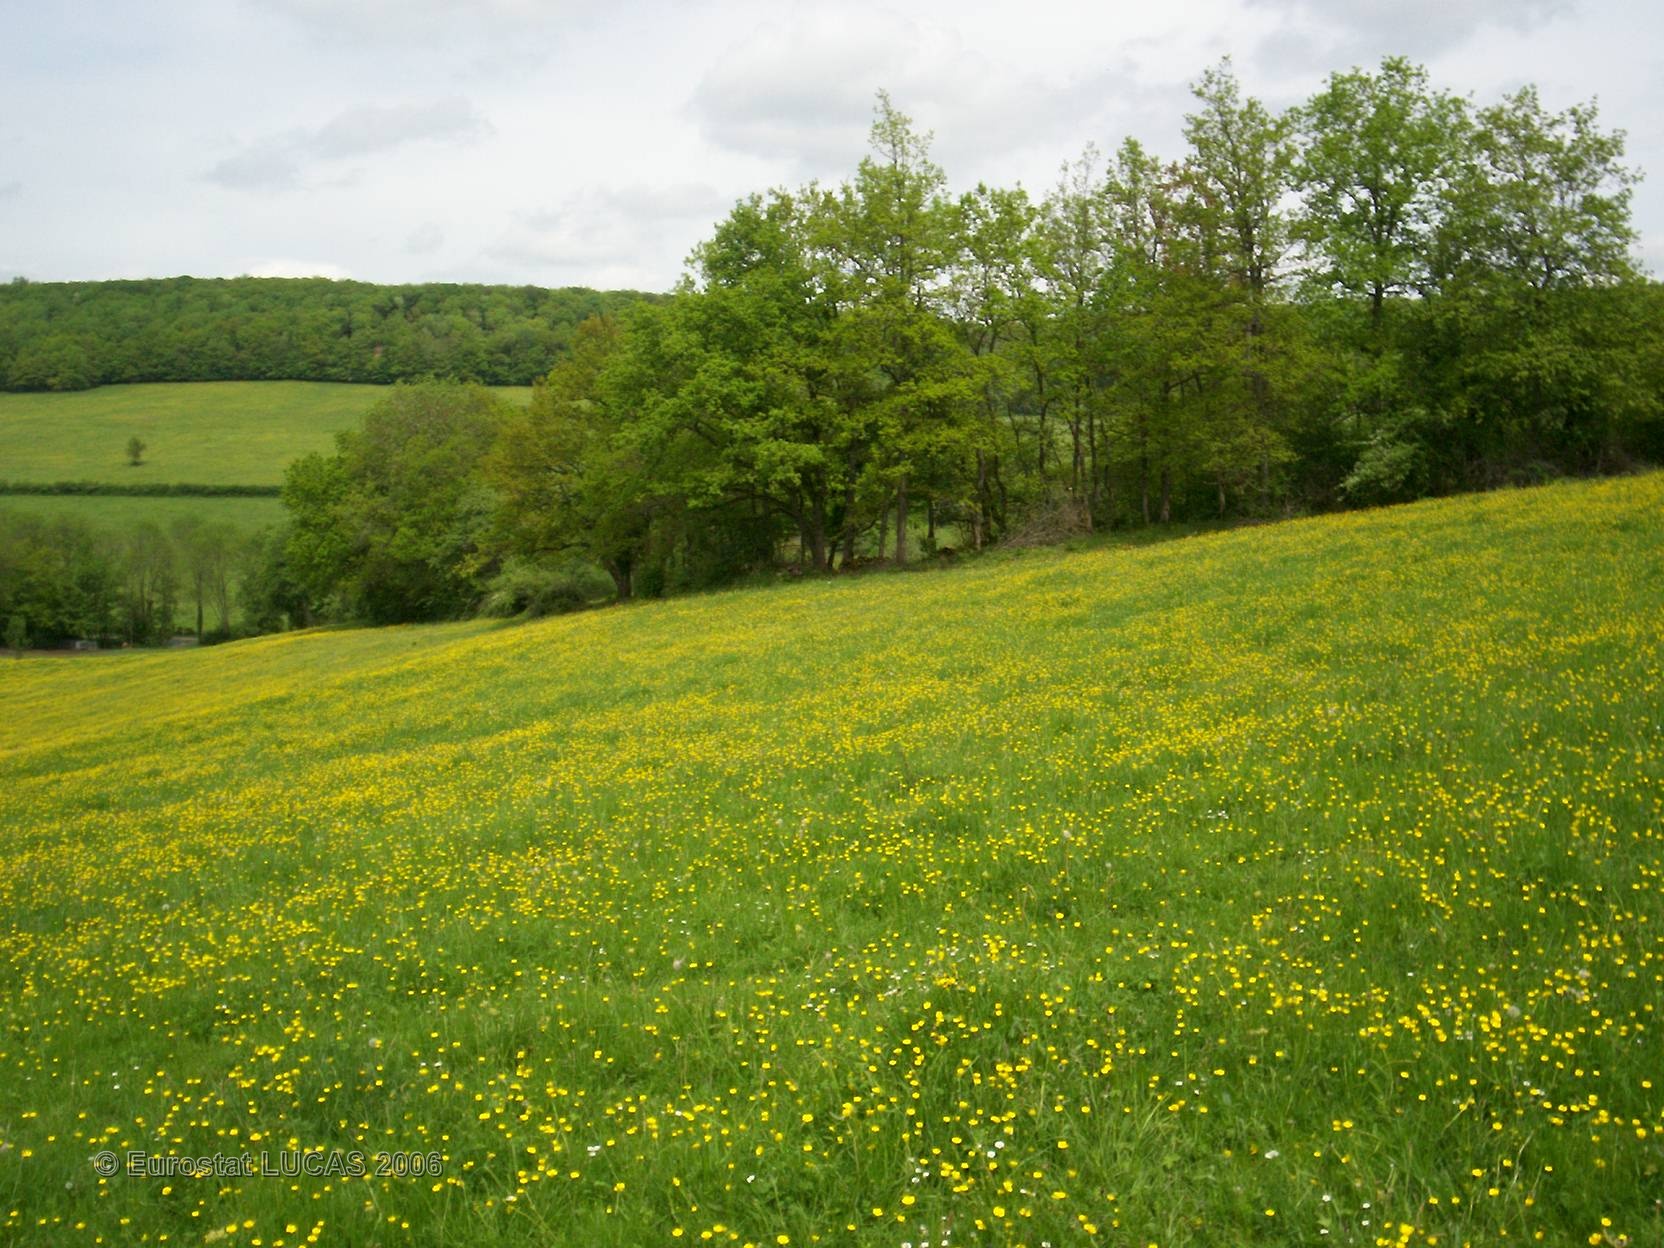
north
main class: Grassland
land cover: Grassland without tree/shrub cover
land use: Agriculture (excluding fallow land and kitchen gardens)
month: May
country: FR
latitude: 47.3137
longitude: 4.5627
